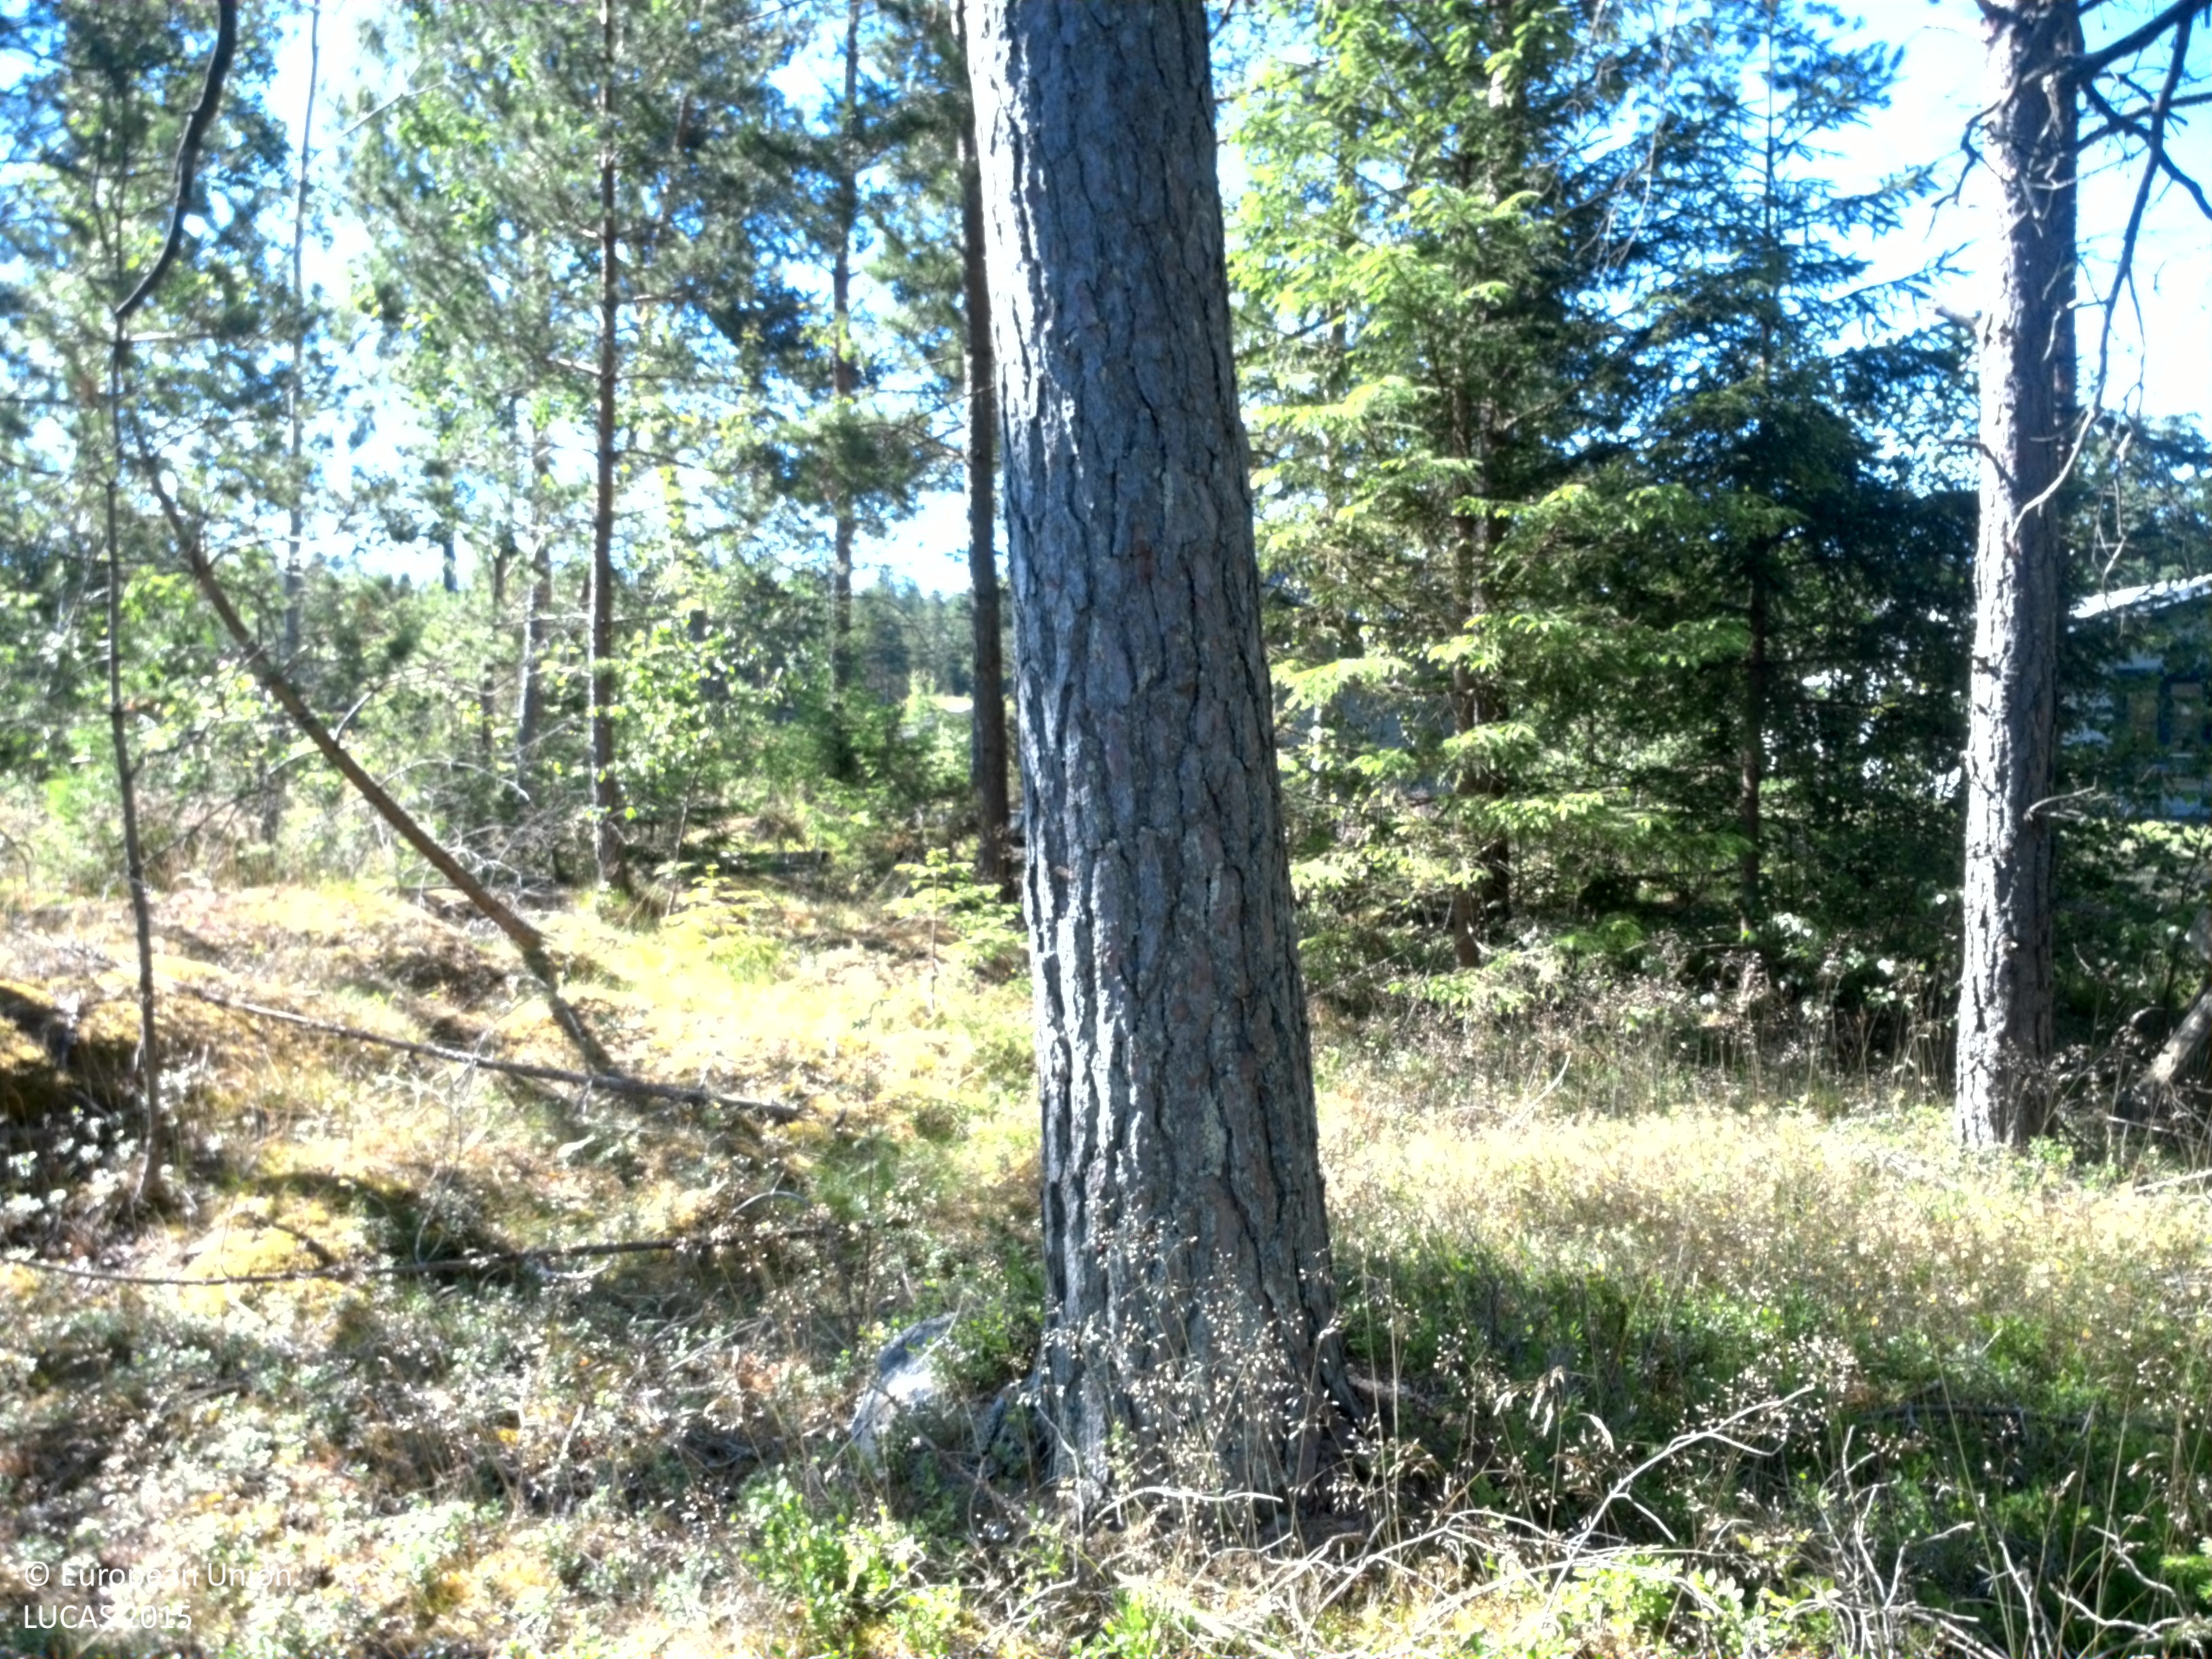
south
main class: Woodland
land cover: Pine dominated mixed woodland
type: boreal forest
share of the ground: 25 - 50 %
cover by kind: coniferous forest trees 35 %, lichens and mosses 25 %, shrubs 20 %, broadleaved forest trees 15 %, herbaceous plants 5 %
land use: Forestry
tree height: > 5 m
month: July
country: SE
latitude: 59.2812
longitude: 13.1344
